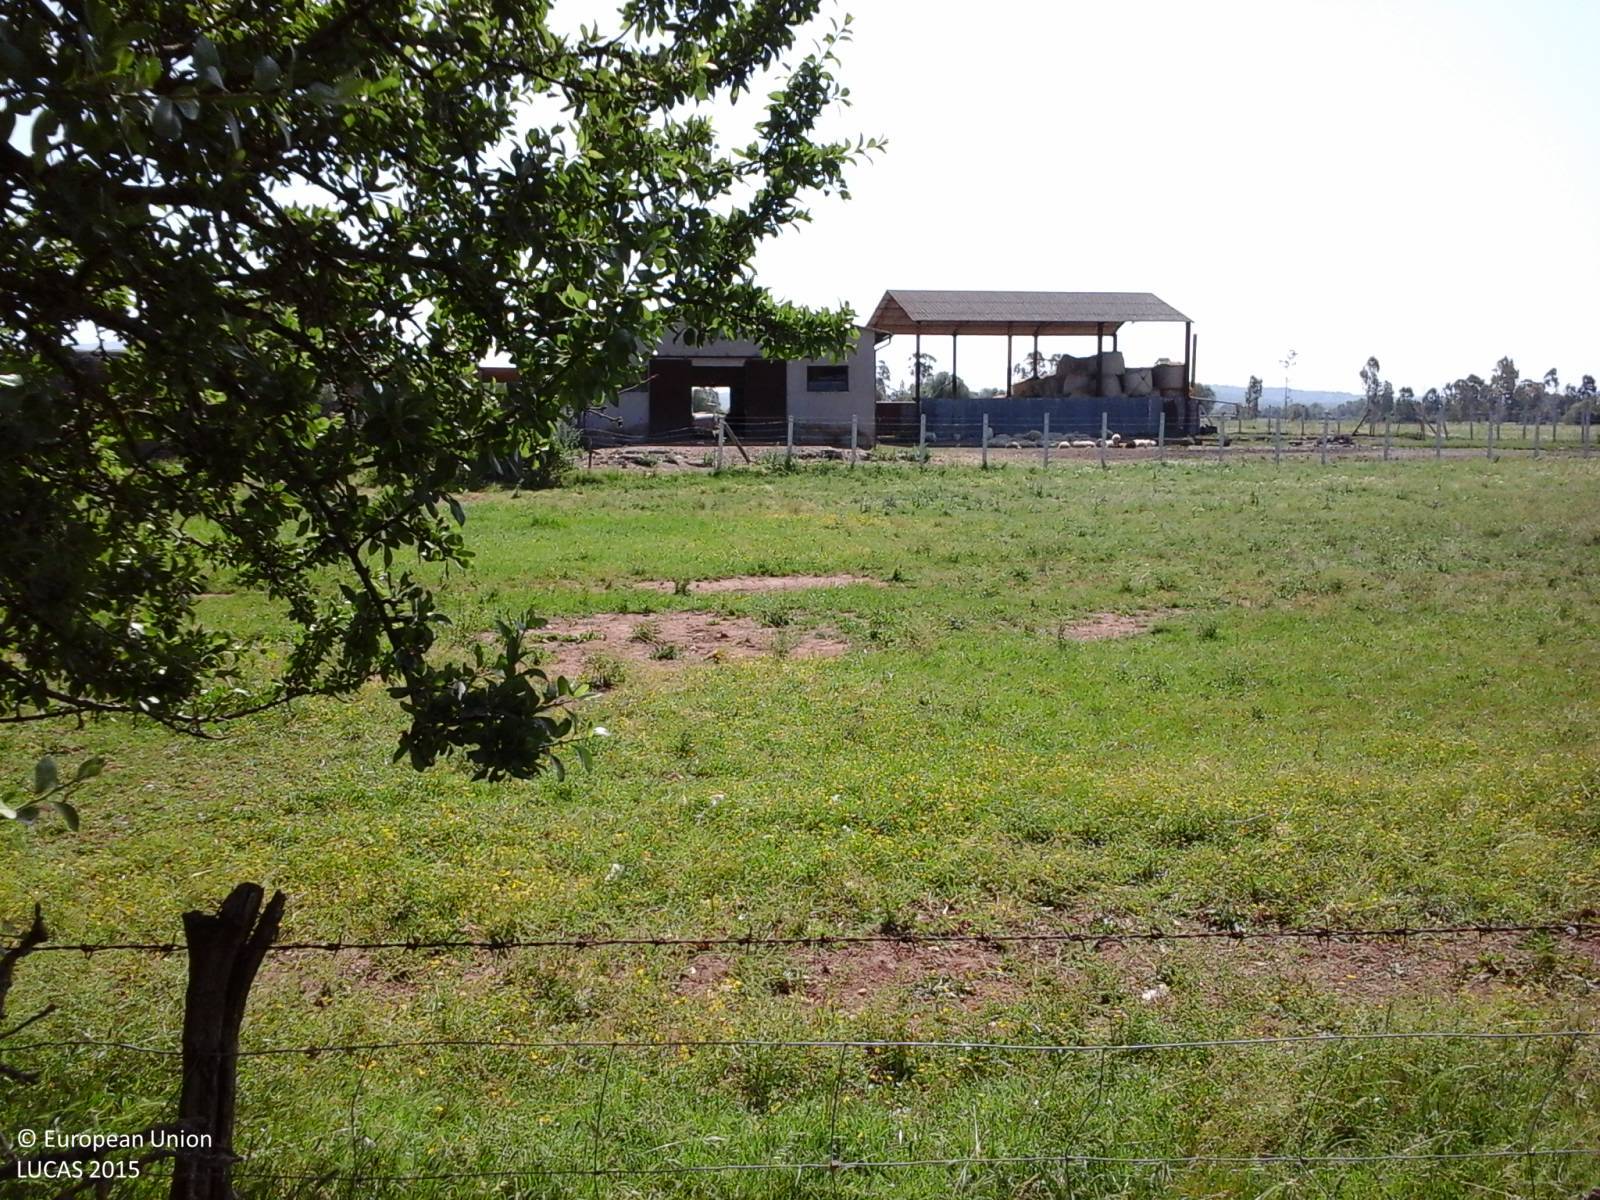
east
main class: Grassland
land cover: Grassland without tree/shrub cover
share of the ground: > 75 %
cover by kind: herbaceous plants 100 %
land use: Agriculture (excluding fallow land and kitchen gardens)
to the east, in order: Grassland without tree/shrub cover; Electric lines; Grassland without tree/shrub cover; Artificial constructions in urban areas; Grassland without tree/shrub cover; Olive groves; Grassland without tree/shrub cover
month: May
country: IT
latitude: 42.3096
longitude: 11.9706
